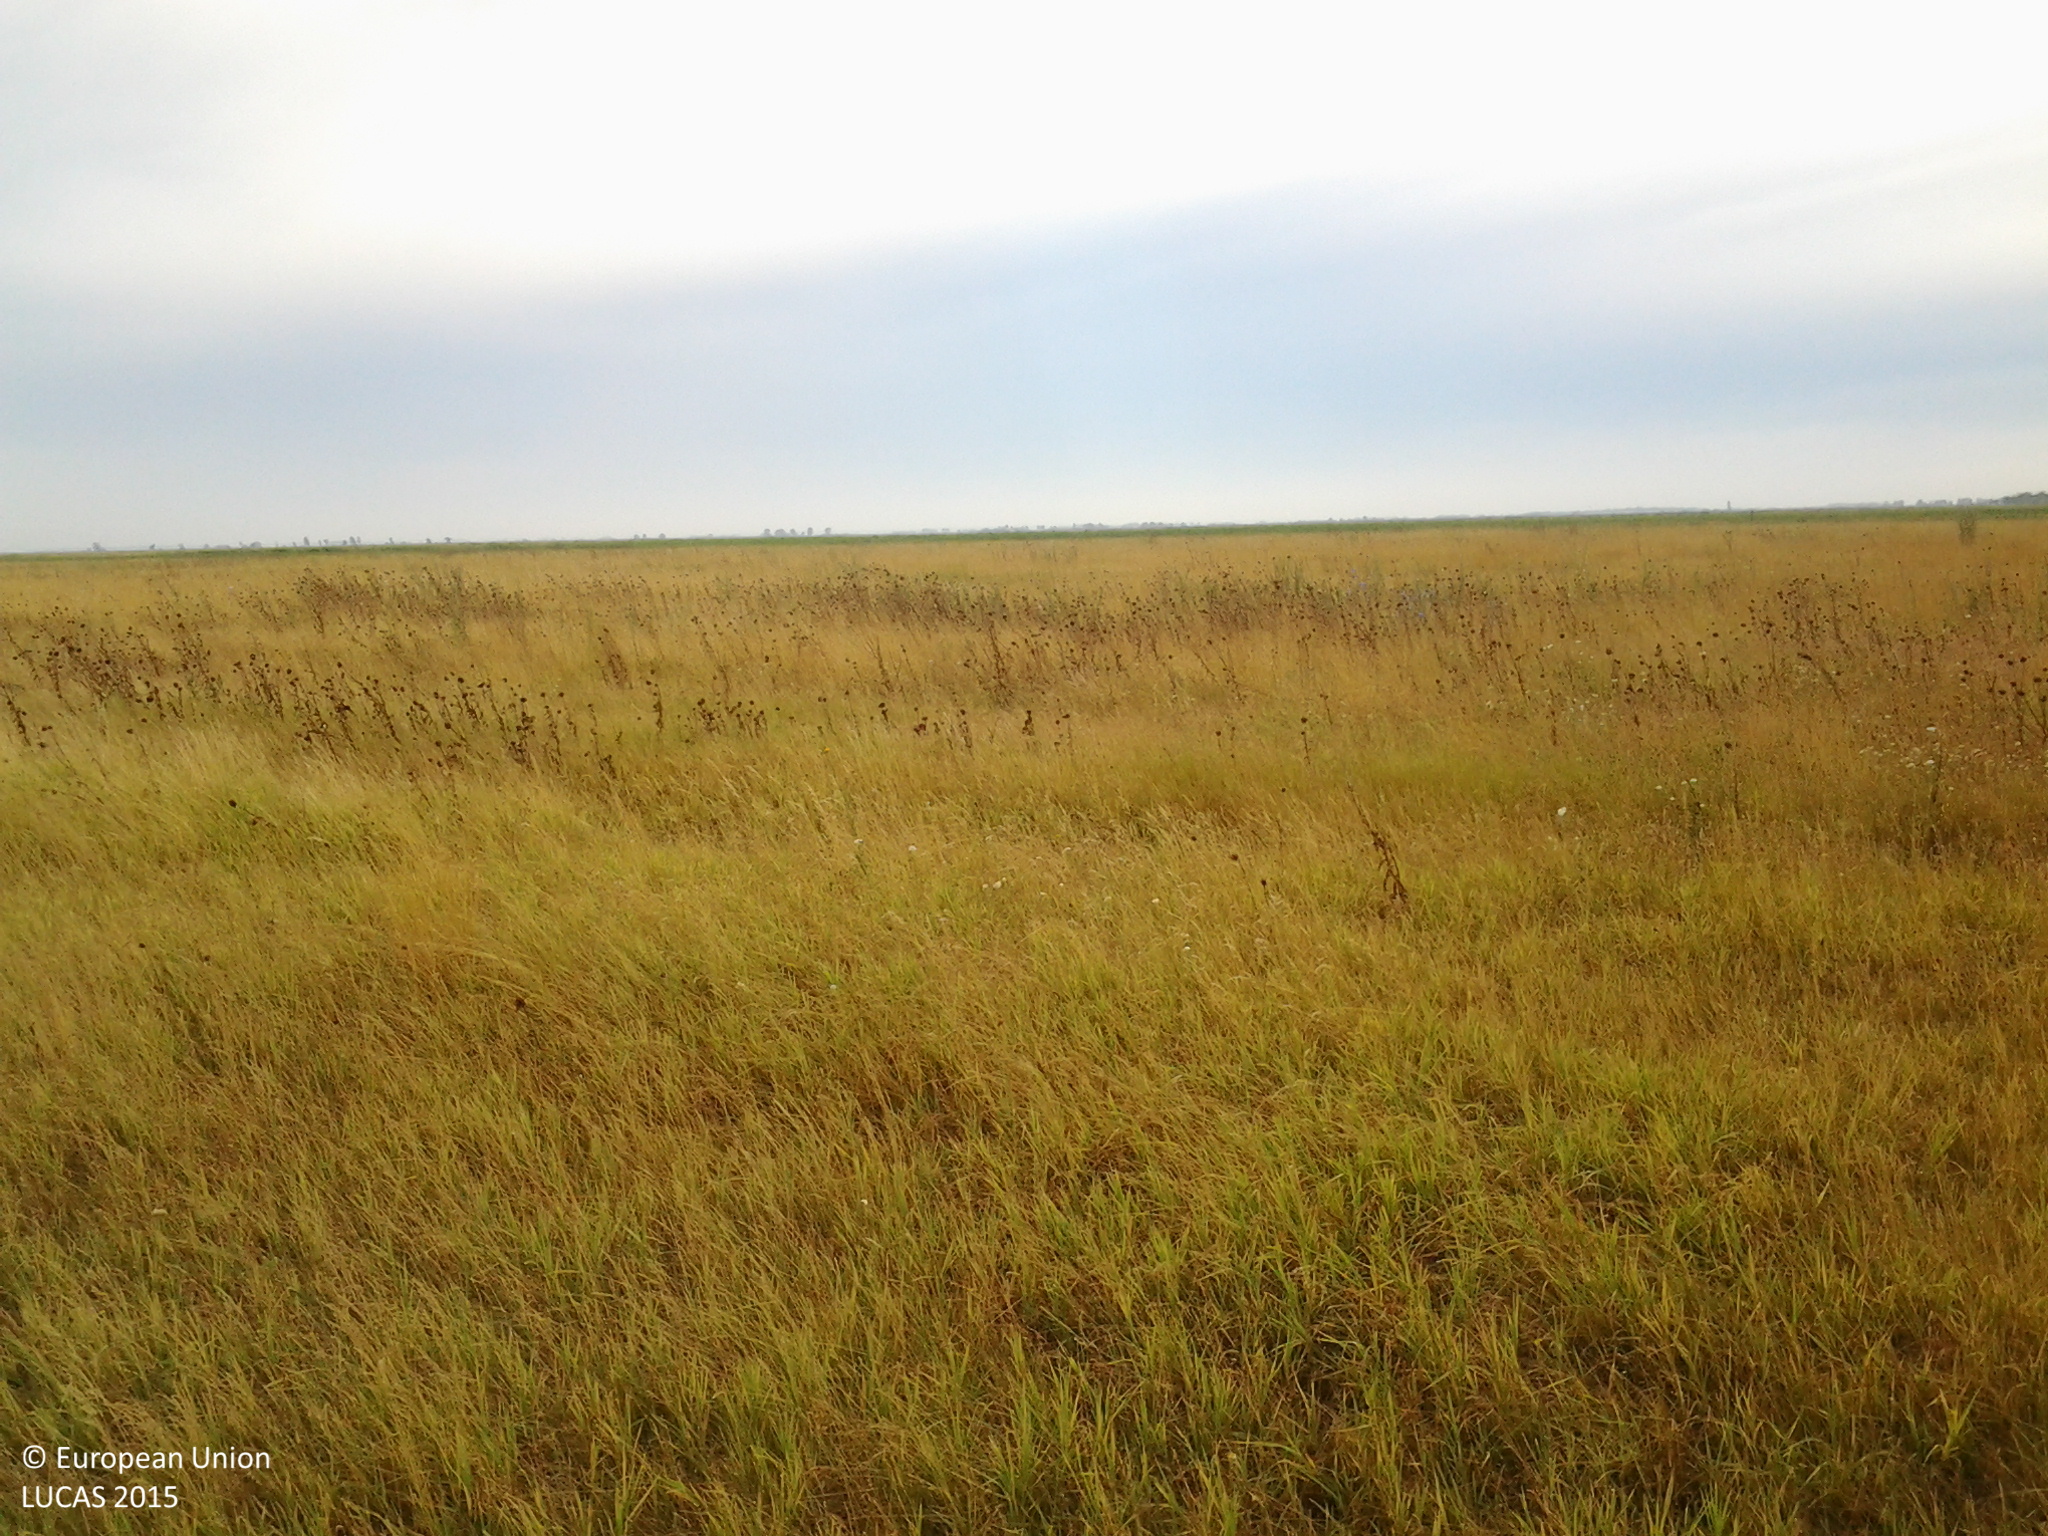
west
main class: Grassland
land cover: Grassland without tree/shrub cover
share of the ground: > 75 %
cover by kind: herbaceous plants 100 %
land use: Agriculture (excluding fallow land and kitchen gardens)
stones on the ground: < 10 %
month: July
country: HU
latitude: 47.0821
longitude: 19.1447
